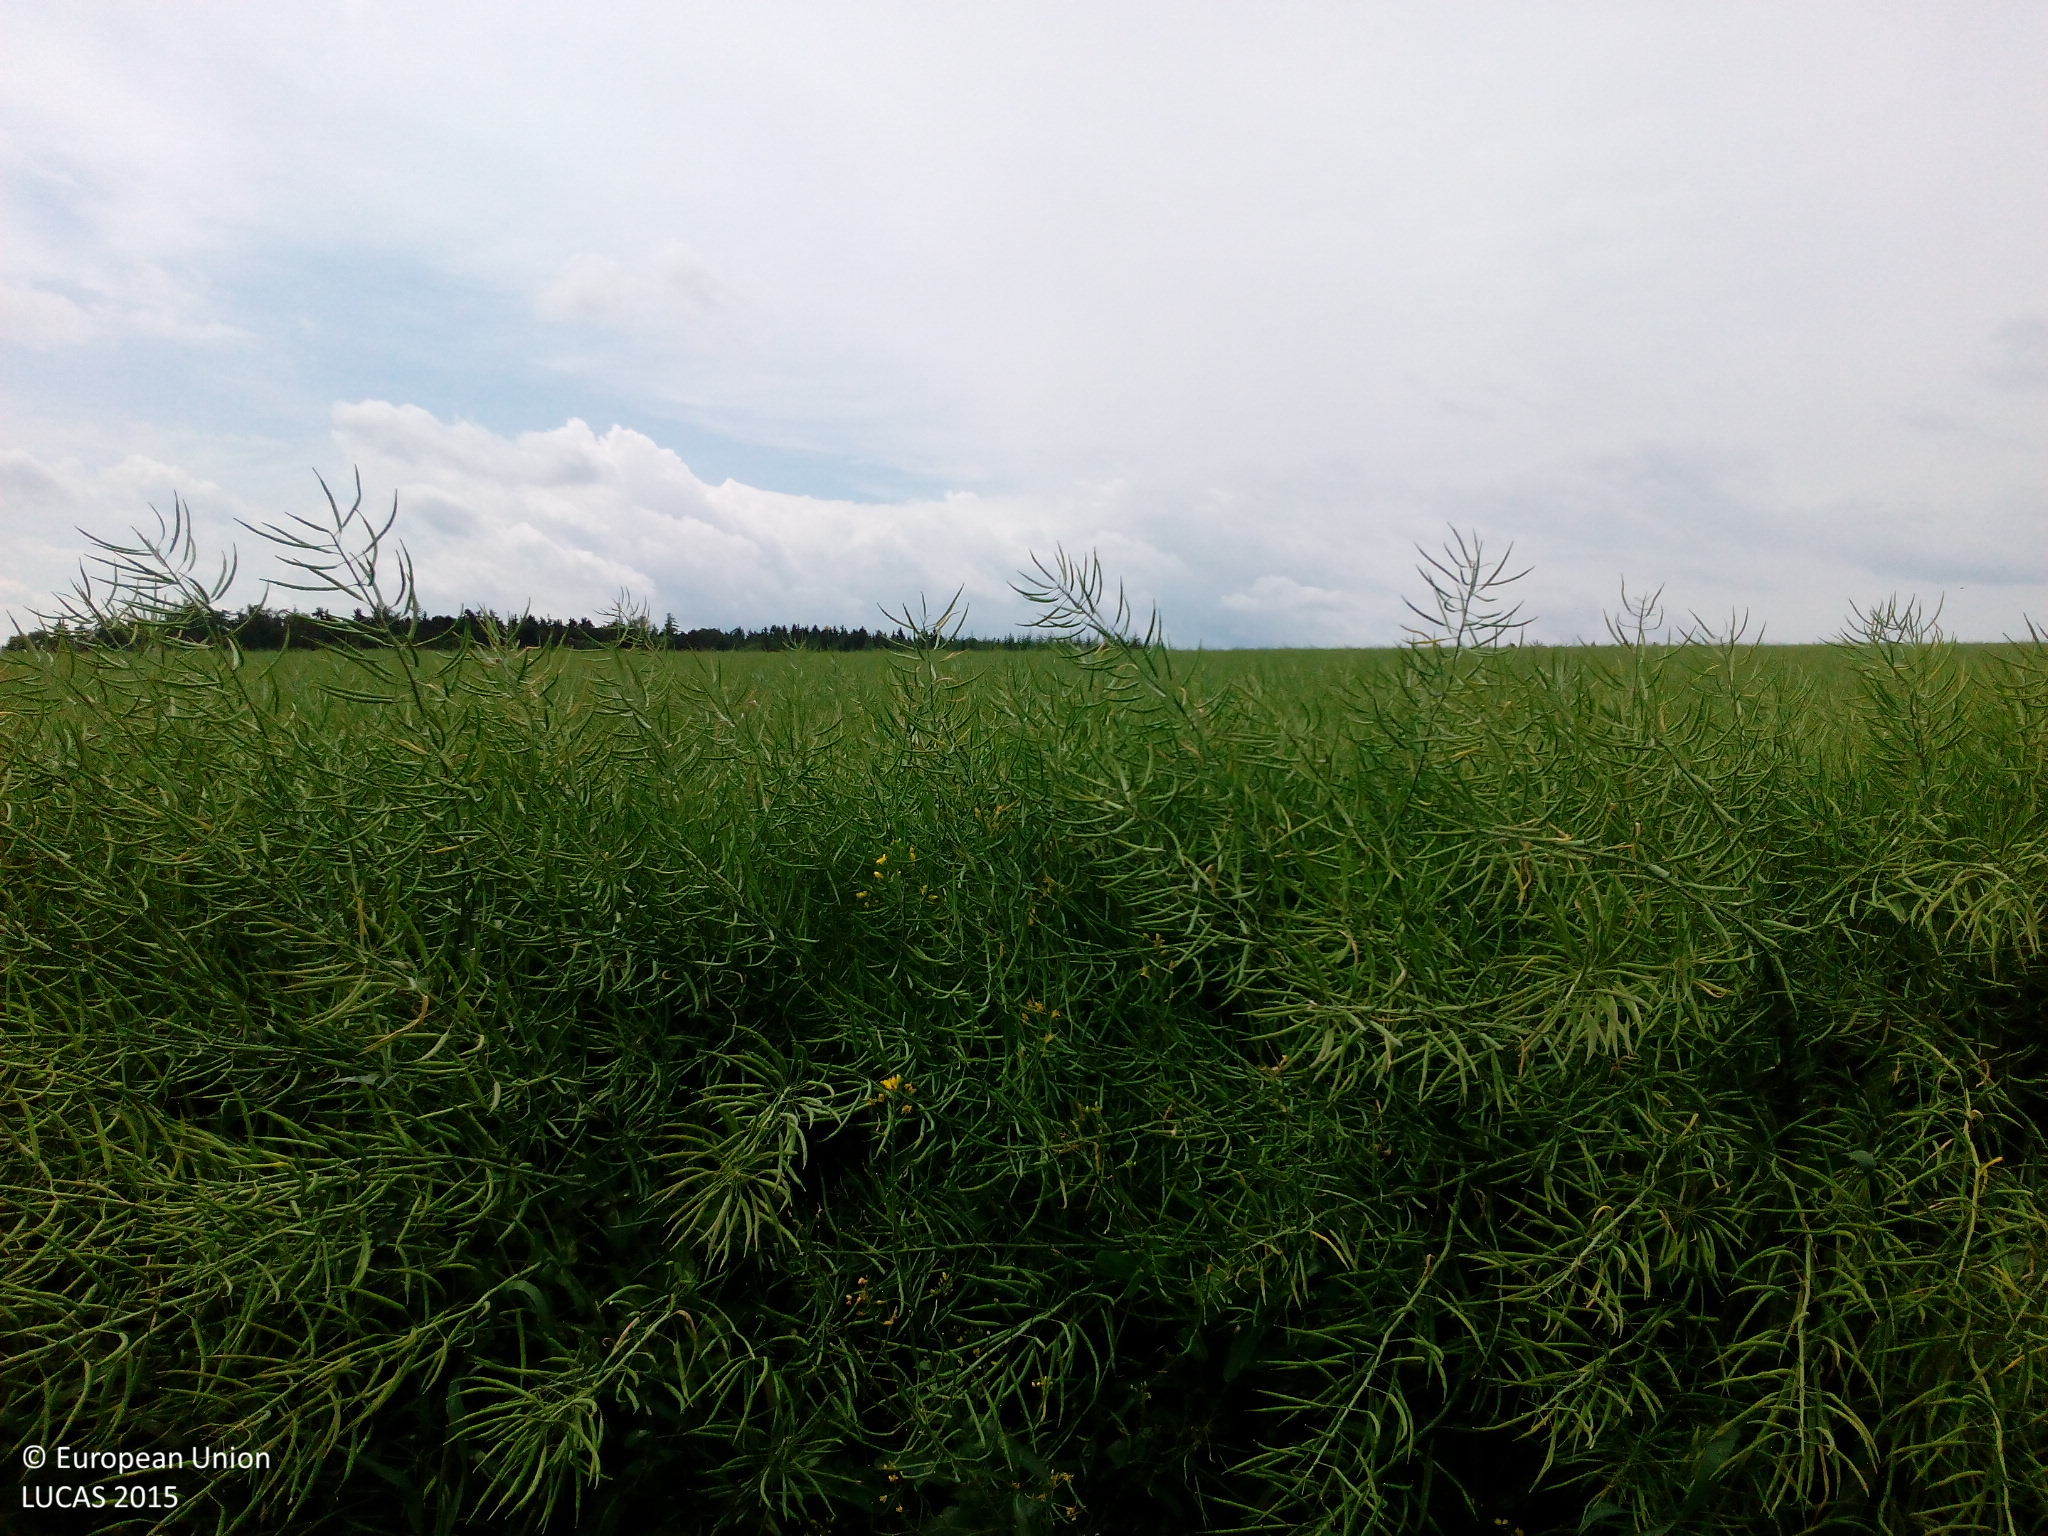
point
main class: Cropland
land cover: Rape and turnip rape
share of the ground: > 75 %
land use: Agriculture (excluding fallow land and kitchen gardens)
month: June
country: DE
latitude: 48.9777
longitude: 12.0898
